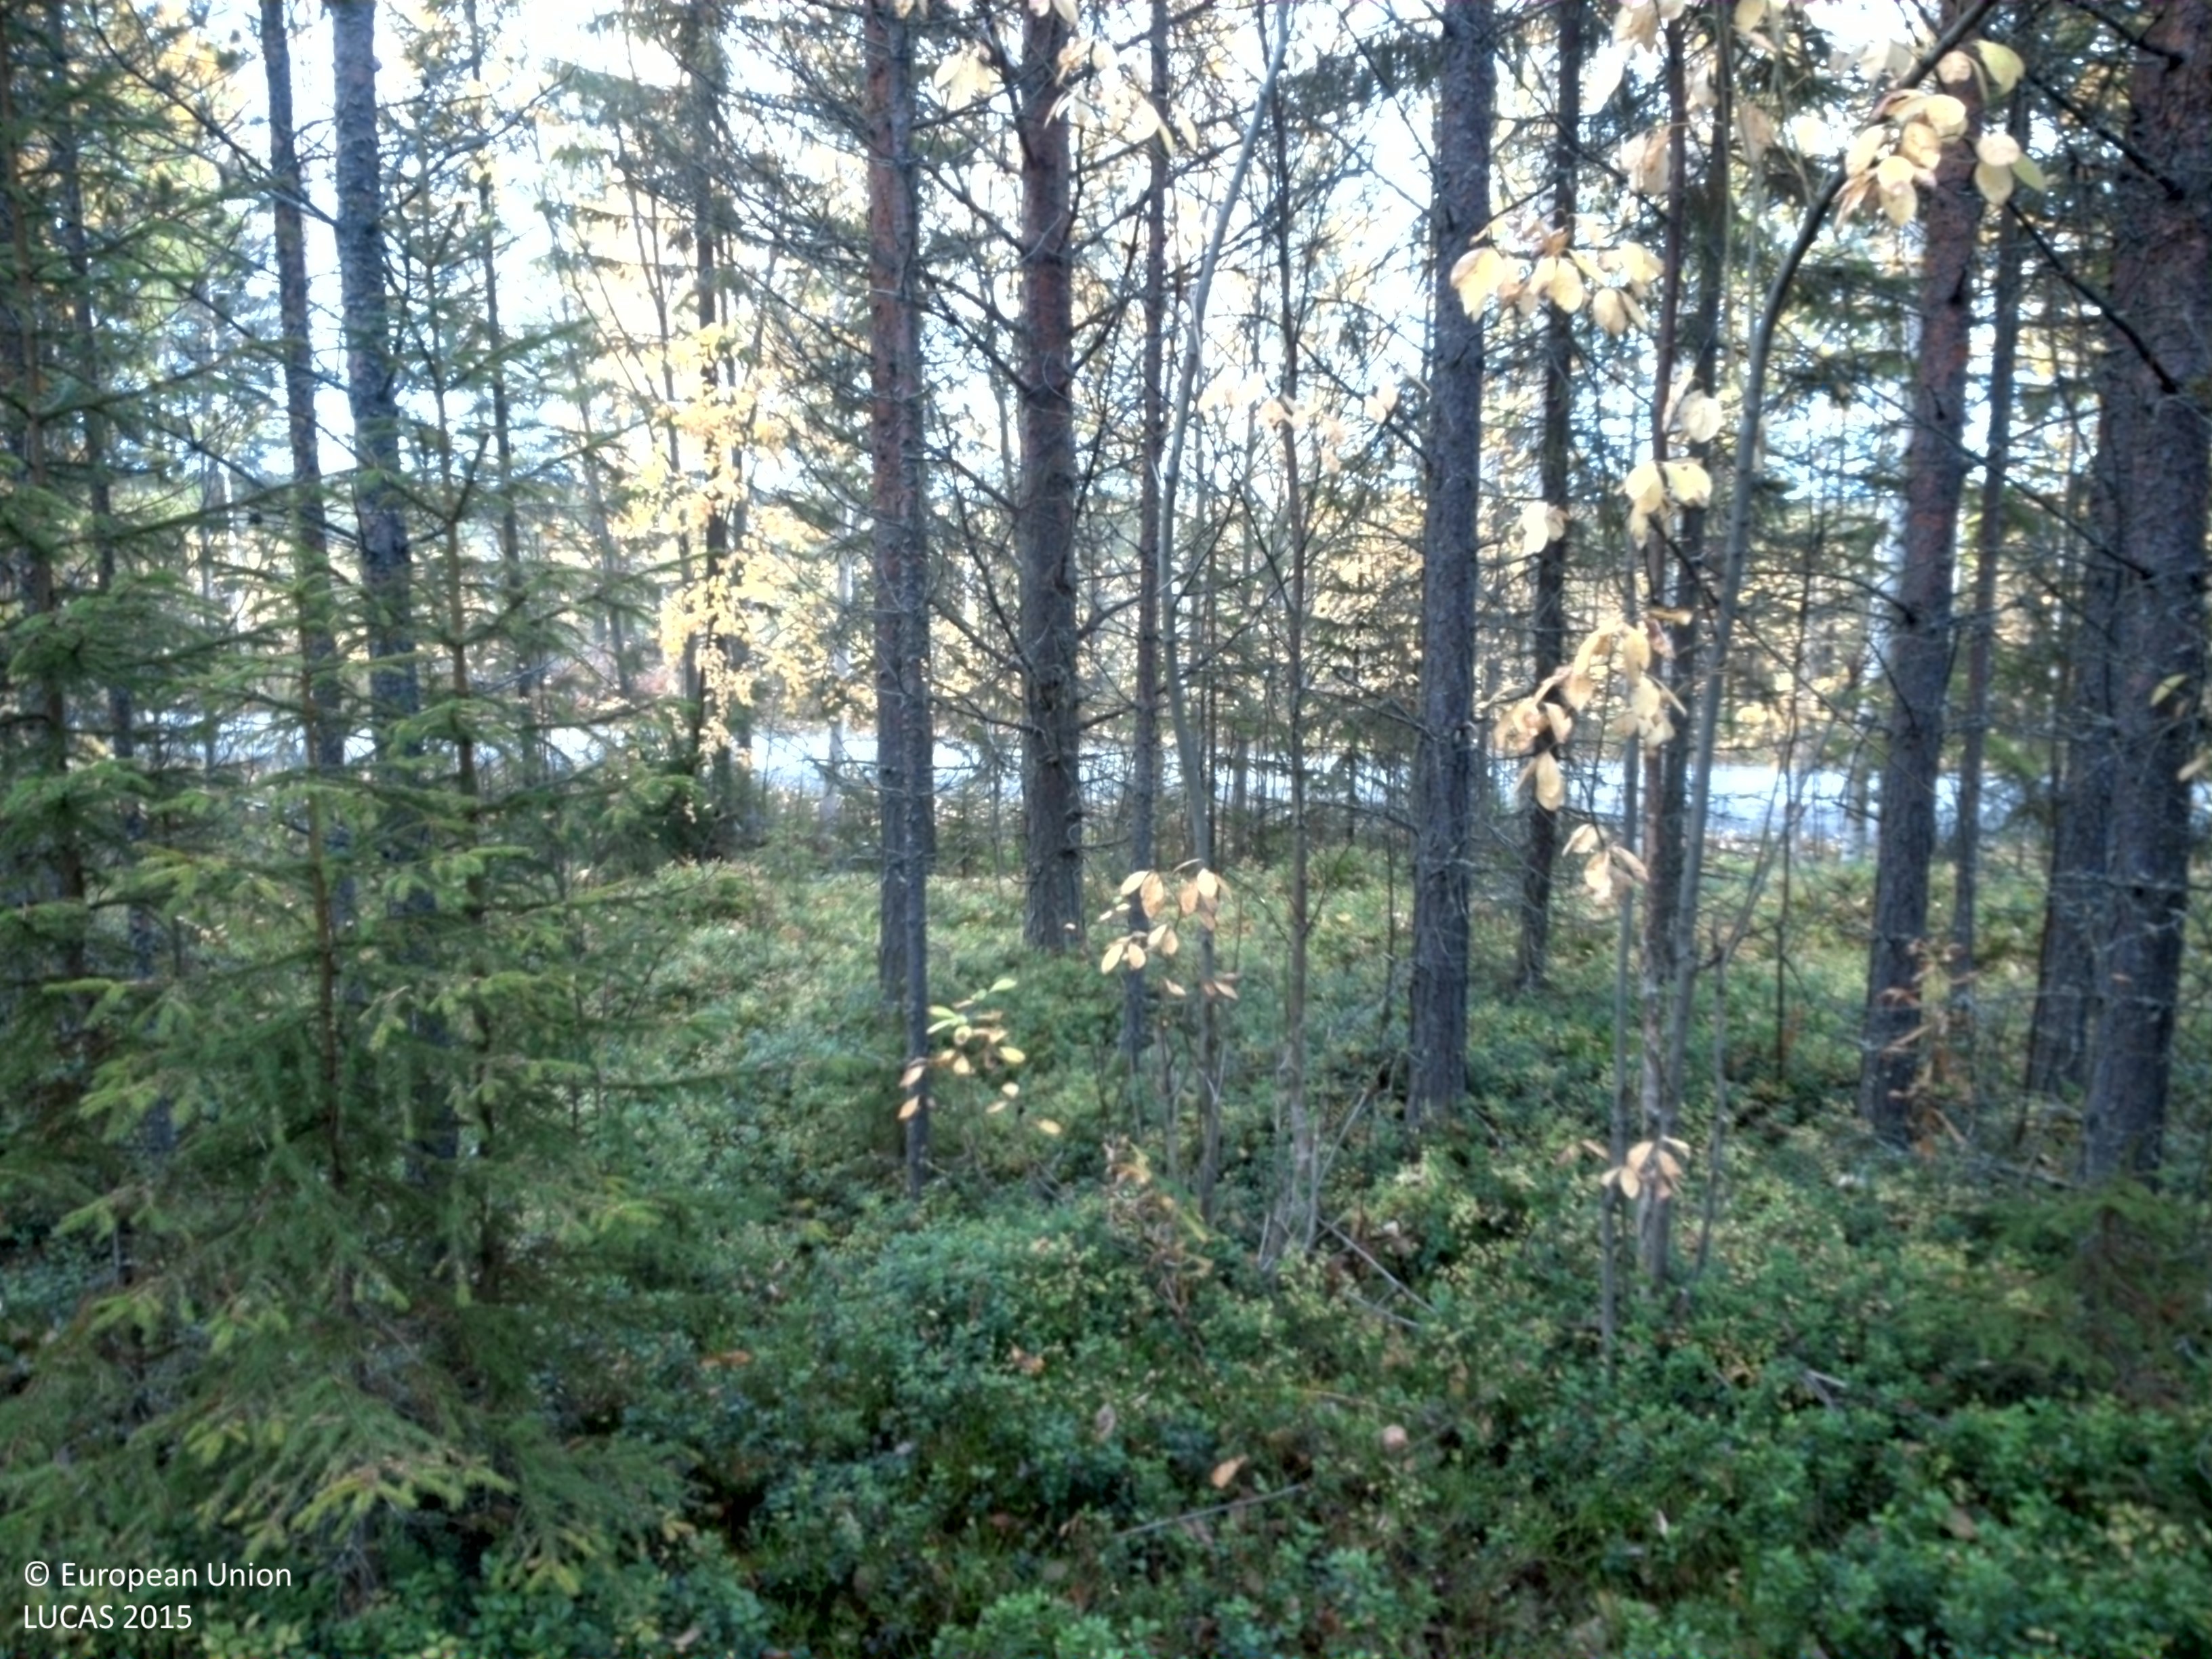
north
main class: Woodland
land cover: Pine dominated coniferous woodland
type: boreal forest
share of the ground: 25 - 50 %
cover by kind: shrubs 45 %, coniferous forest trees 35 %, lichens and mosses 15 %, broadleaved forest trees 5 %
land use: Forestry
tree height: > 5 m
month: September
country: SE
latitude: 64.9143
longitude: 17.8068
